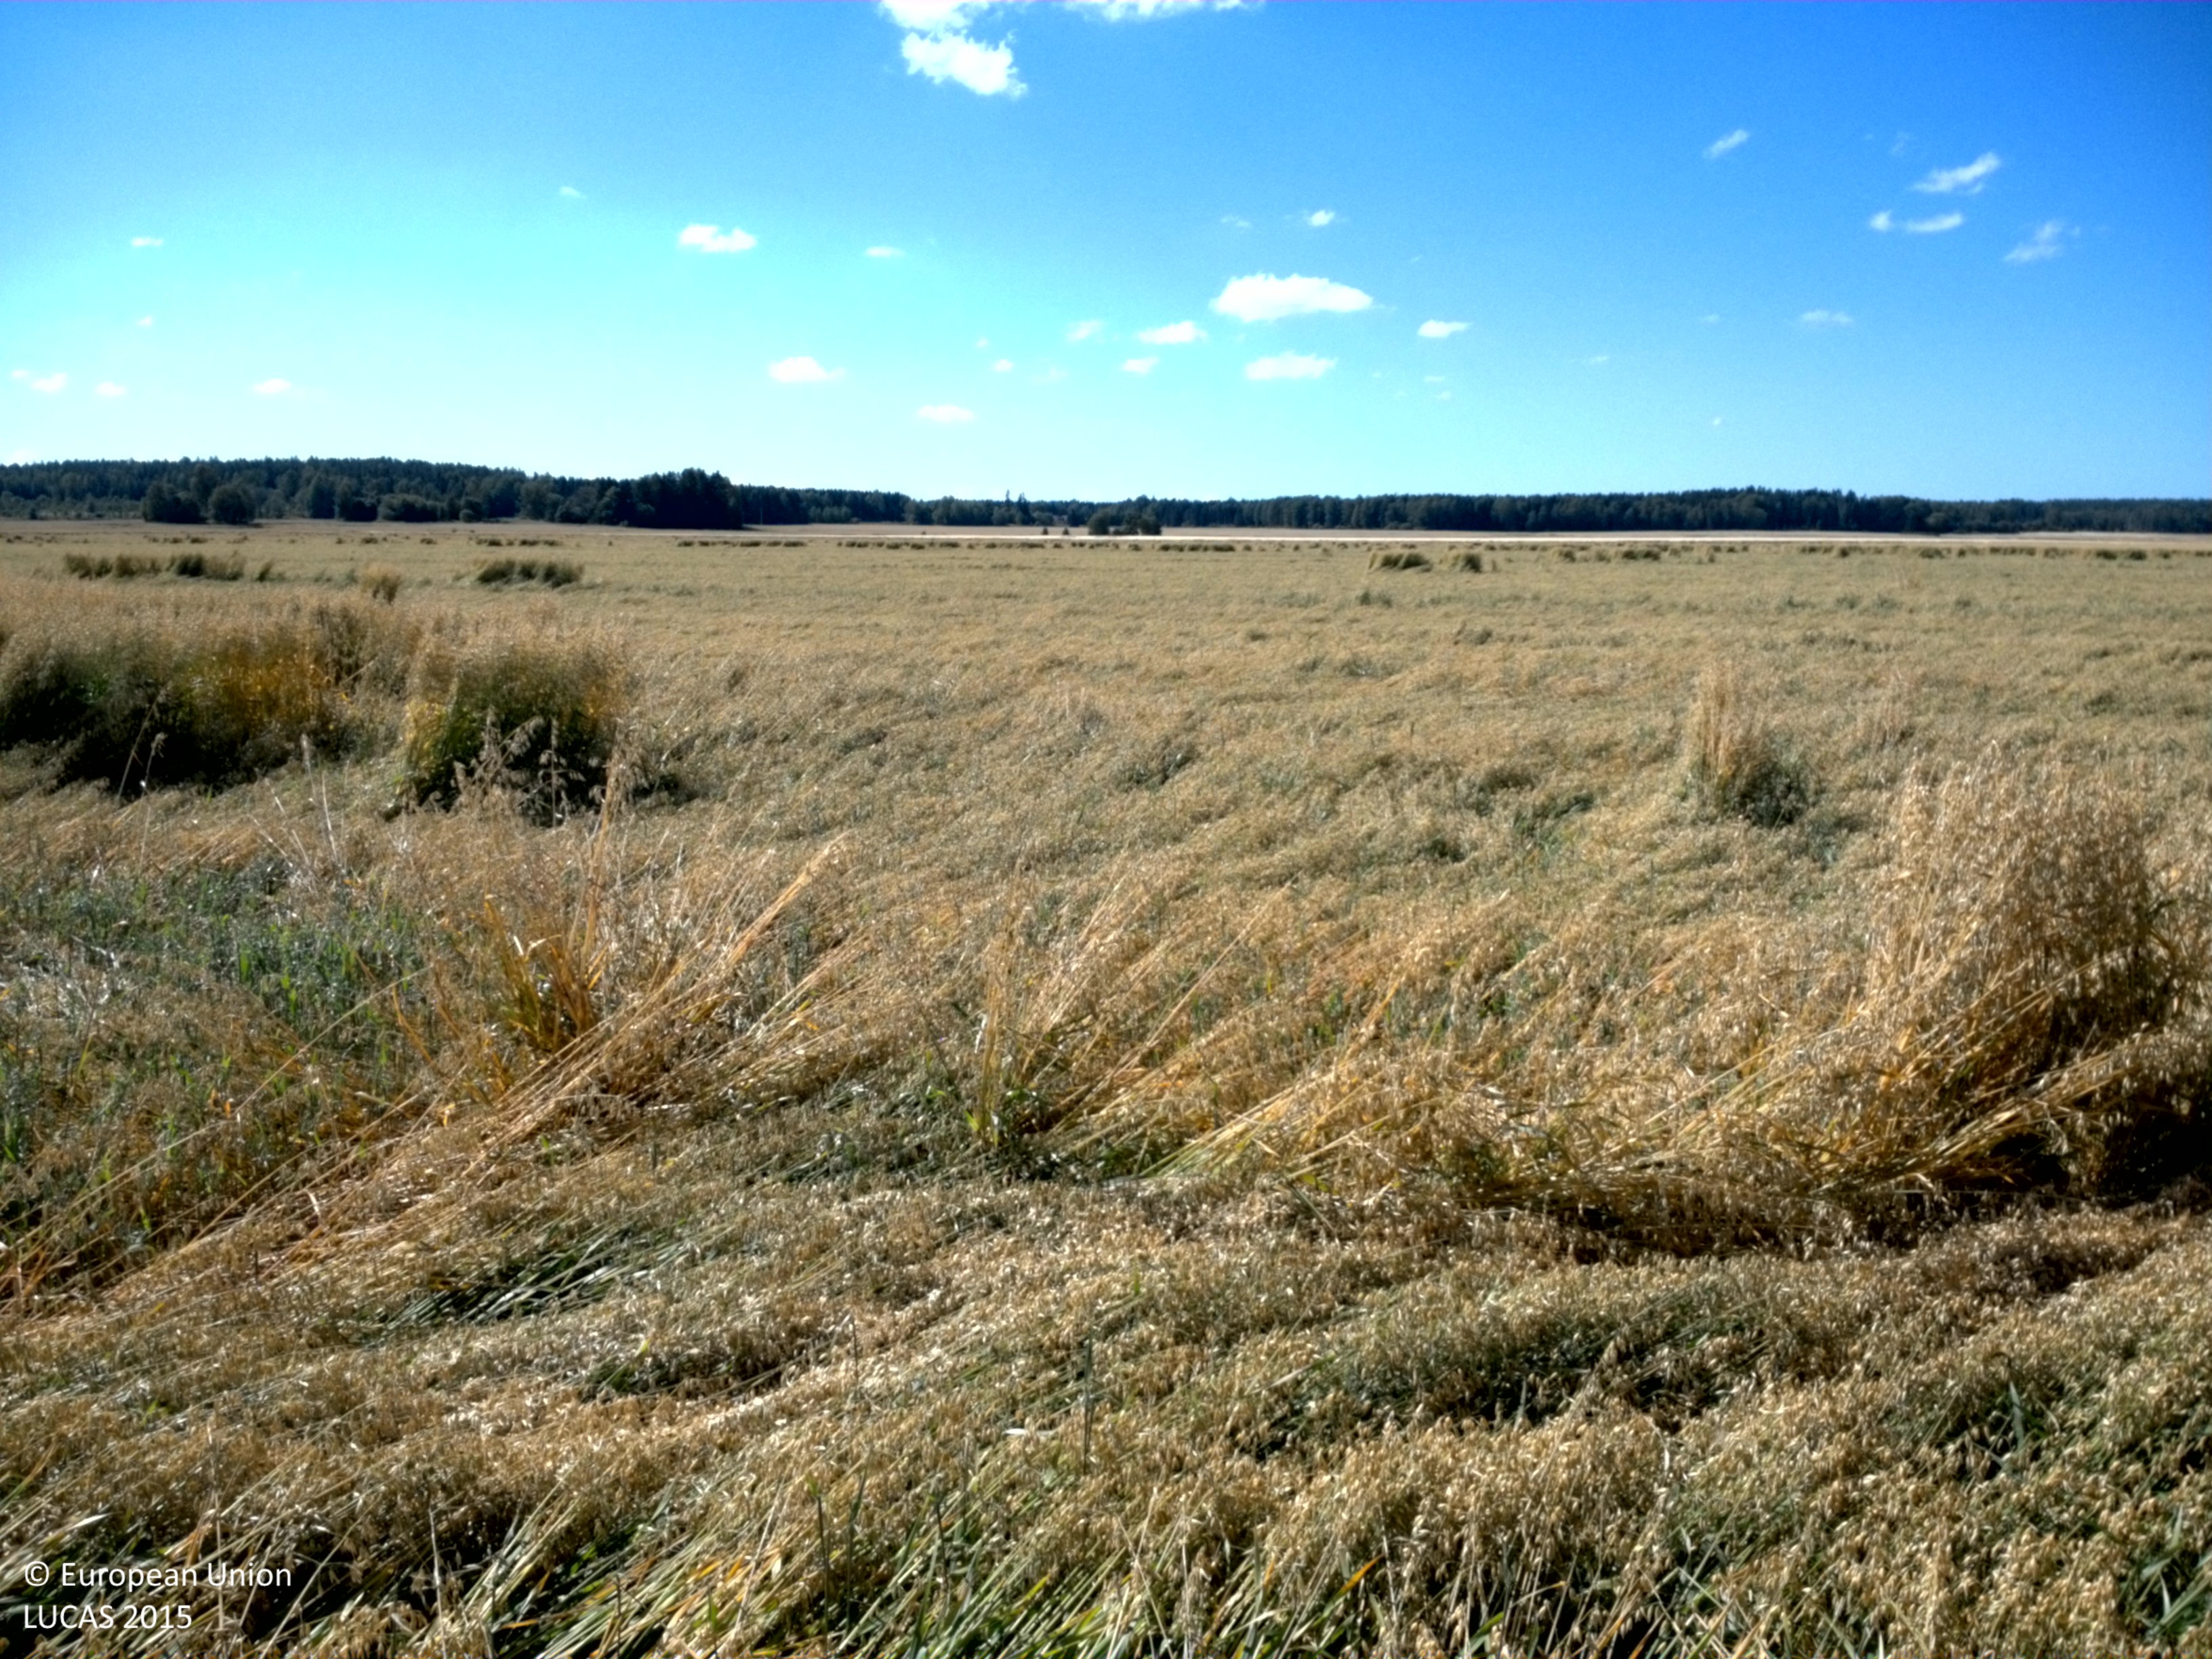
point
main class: Cropland
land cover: Oats
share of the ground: > 75 %
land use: Agriculture (excluding fallow land and kitchen gardens)
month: August
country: SE
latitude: 59.7716
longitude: 16.6340
